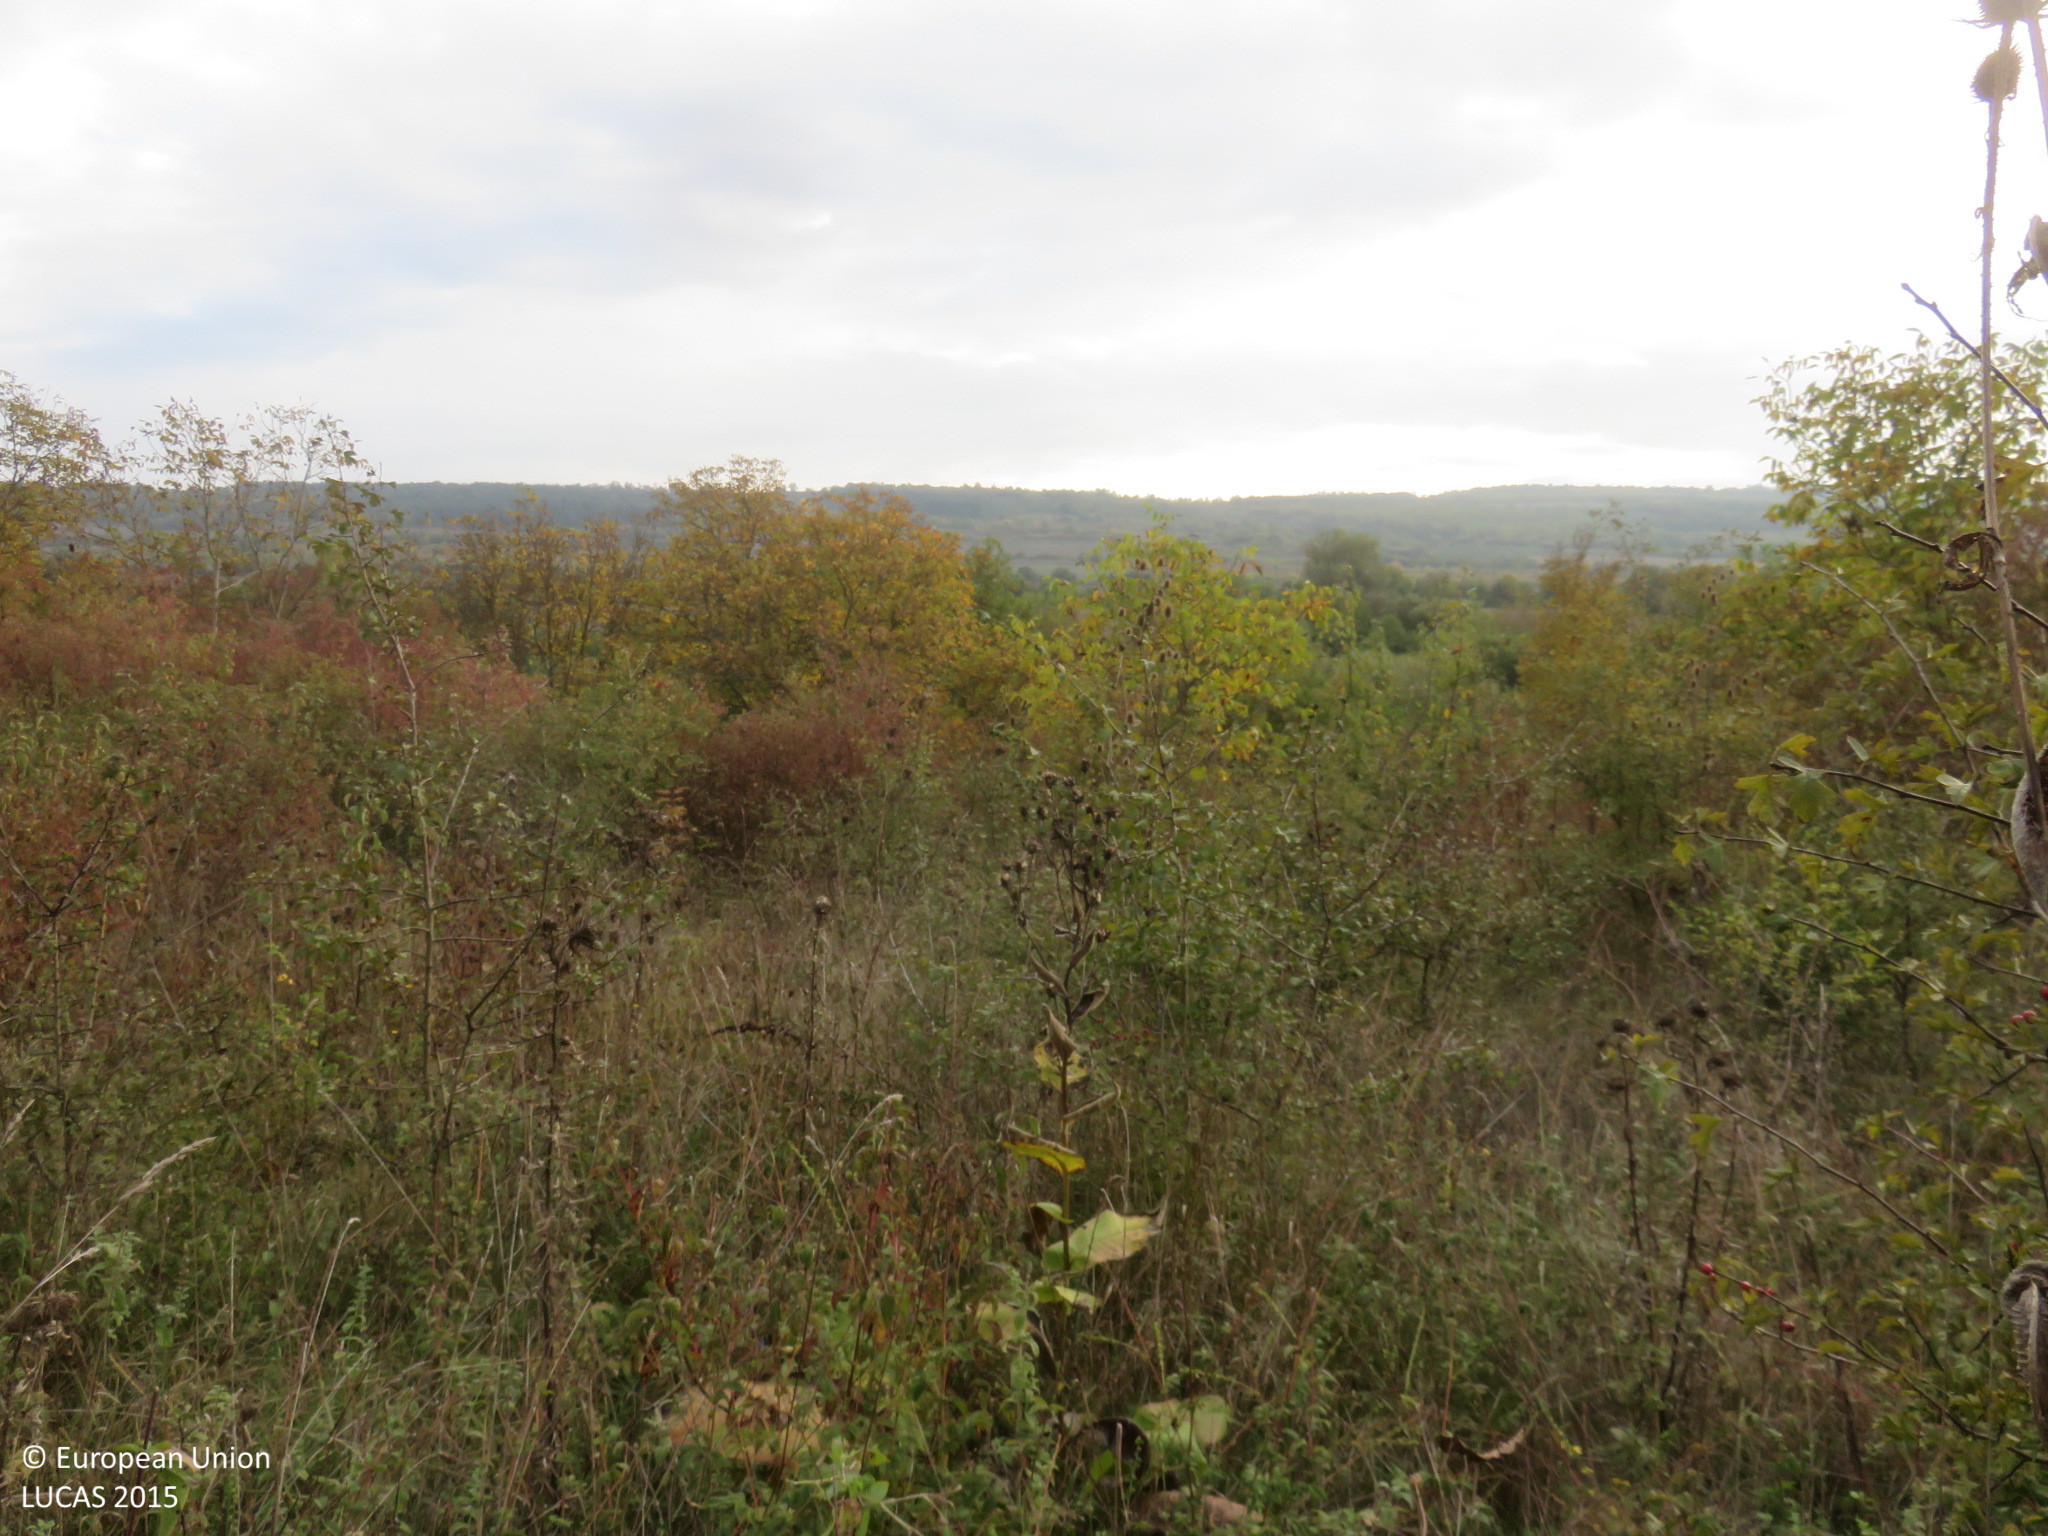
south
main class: Shrubland
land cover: Shrubland with sparse tree cover
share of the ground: > 75 %
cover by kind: shrubs 95 %, broadleaved forest trees 5 %
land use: Abandoned areas
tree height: < 5 m
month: October
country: BG
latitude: 43.1235
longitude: 25.2521
